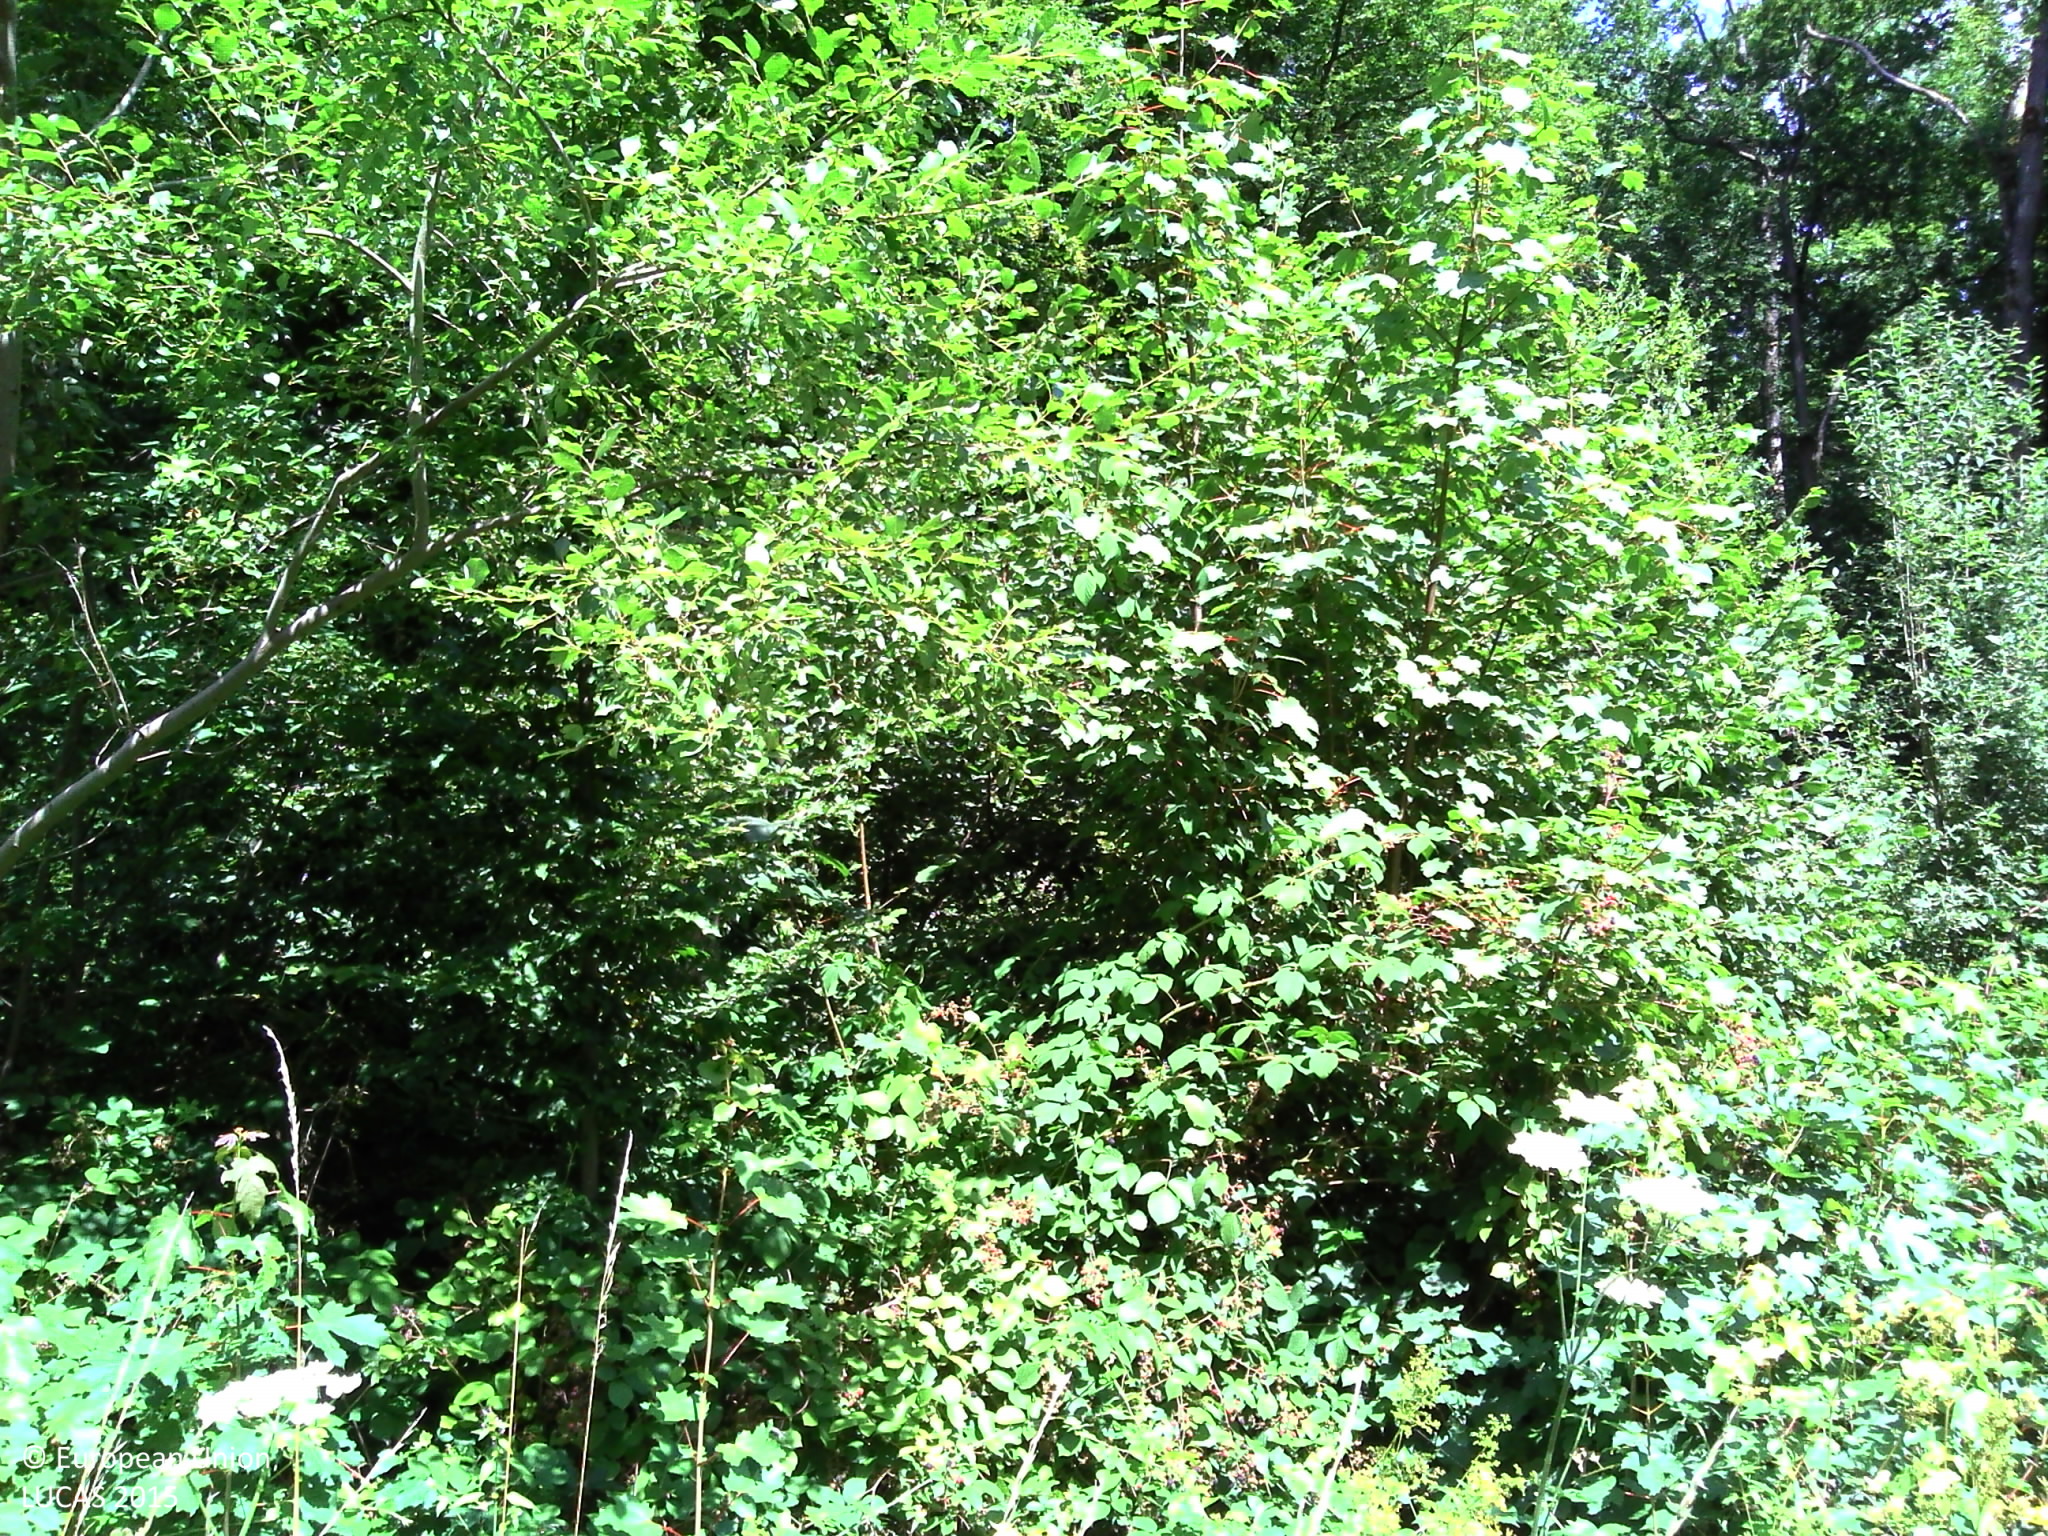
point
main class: Woodland
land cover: Broadleaved woodland
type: mesophytic deciduous forest
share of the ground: > 75 %
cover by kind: broadleaved forest trees 85 %, herbaceous plants 10 %, lichens and mosses 5 %
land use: Forestry
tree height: > 5 m
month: August
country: FR
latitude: 49.9922
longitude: 4.0384
